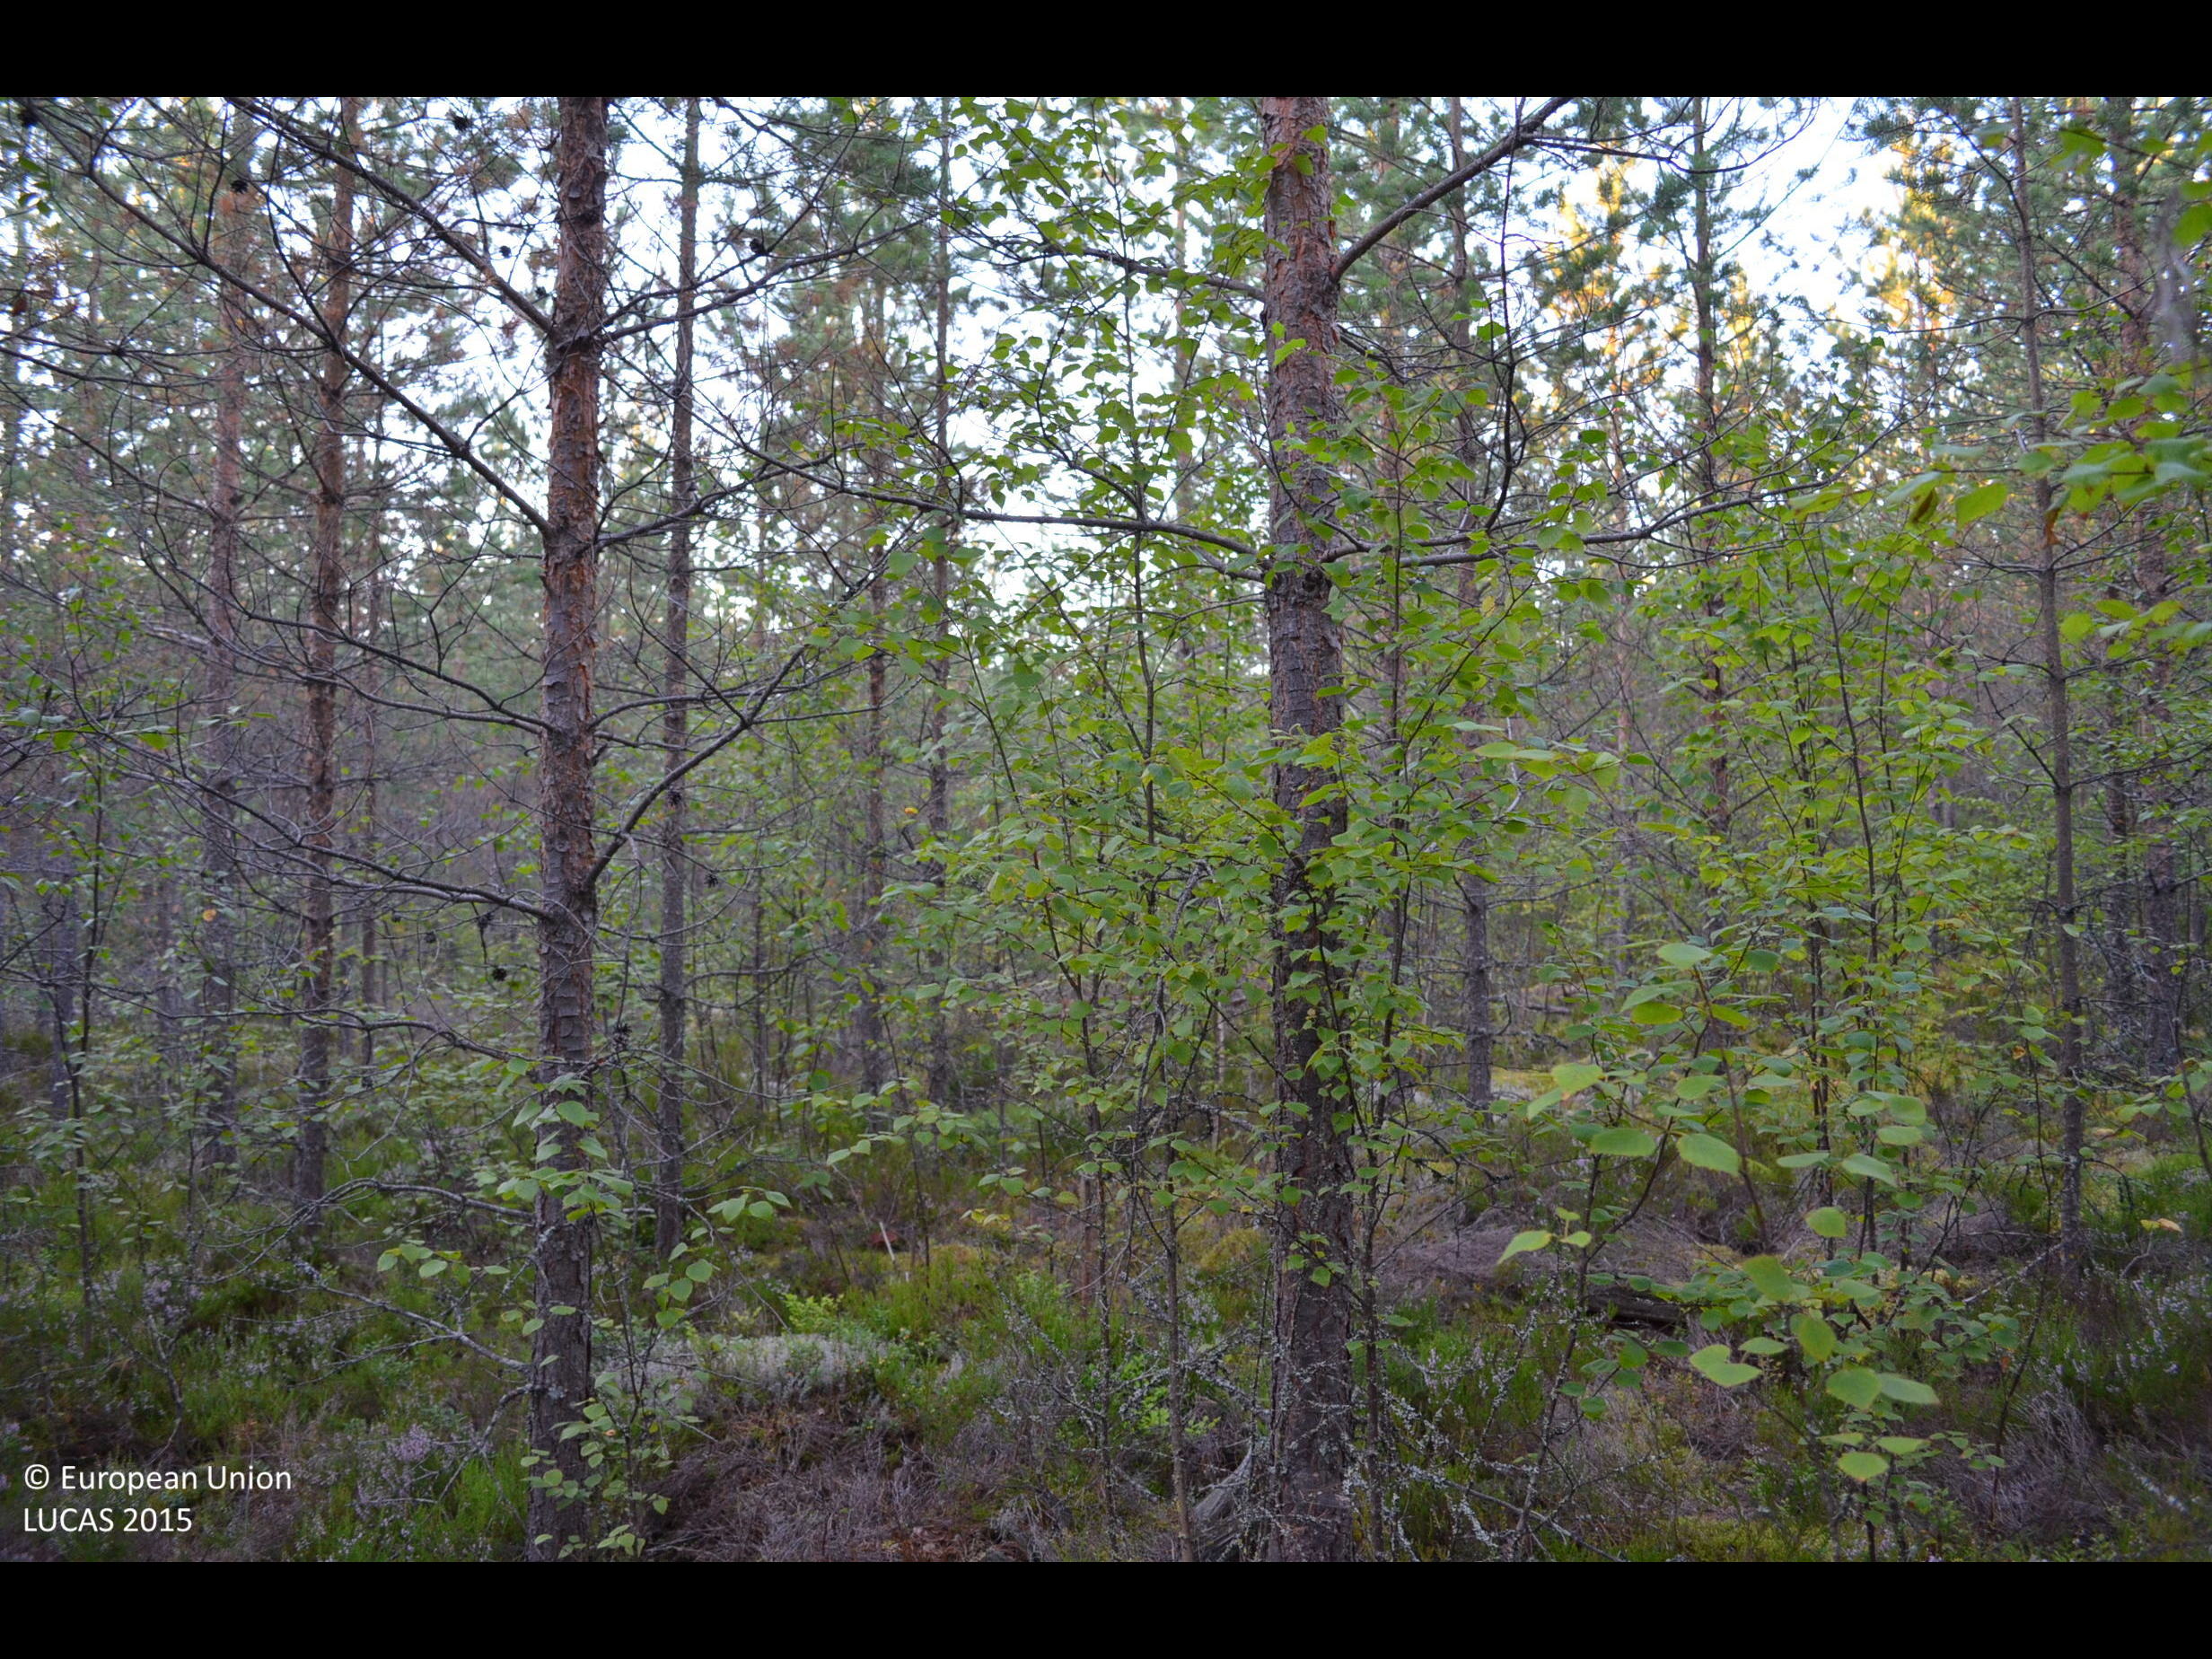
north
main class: Woodland
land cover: Pine dominated coniferous woodland
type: boreal forest
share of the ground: > 75 %
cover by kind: coniferous forest trees 65 %, shrubs 20 %, broadleaved forest trees 15 %
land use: Forestry
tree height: > 5 m
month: August
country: FI
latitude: 62.3735
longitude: 24.4132
